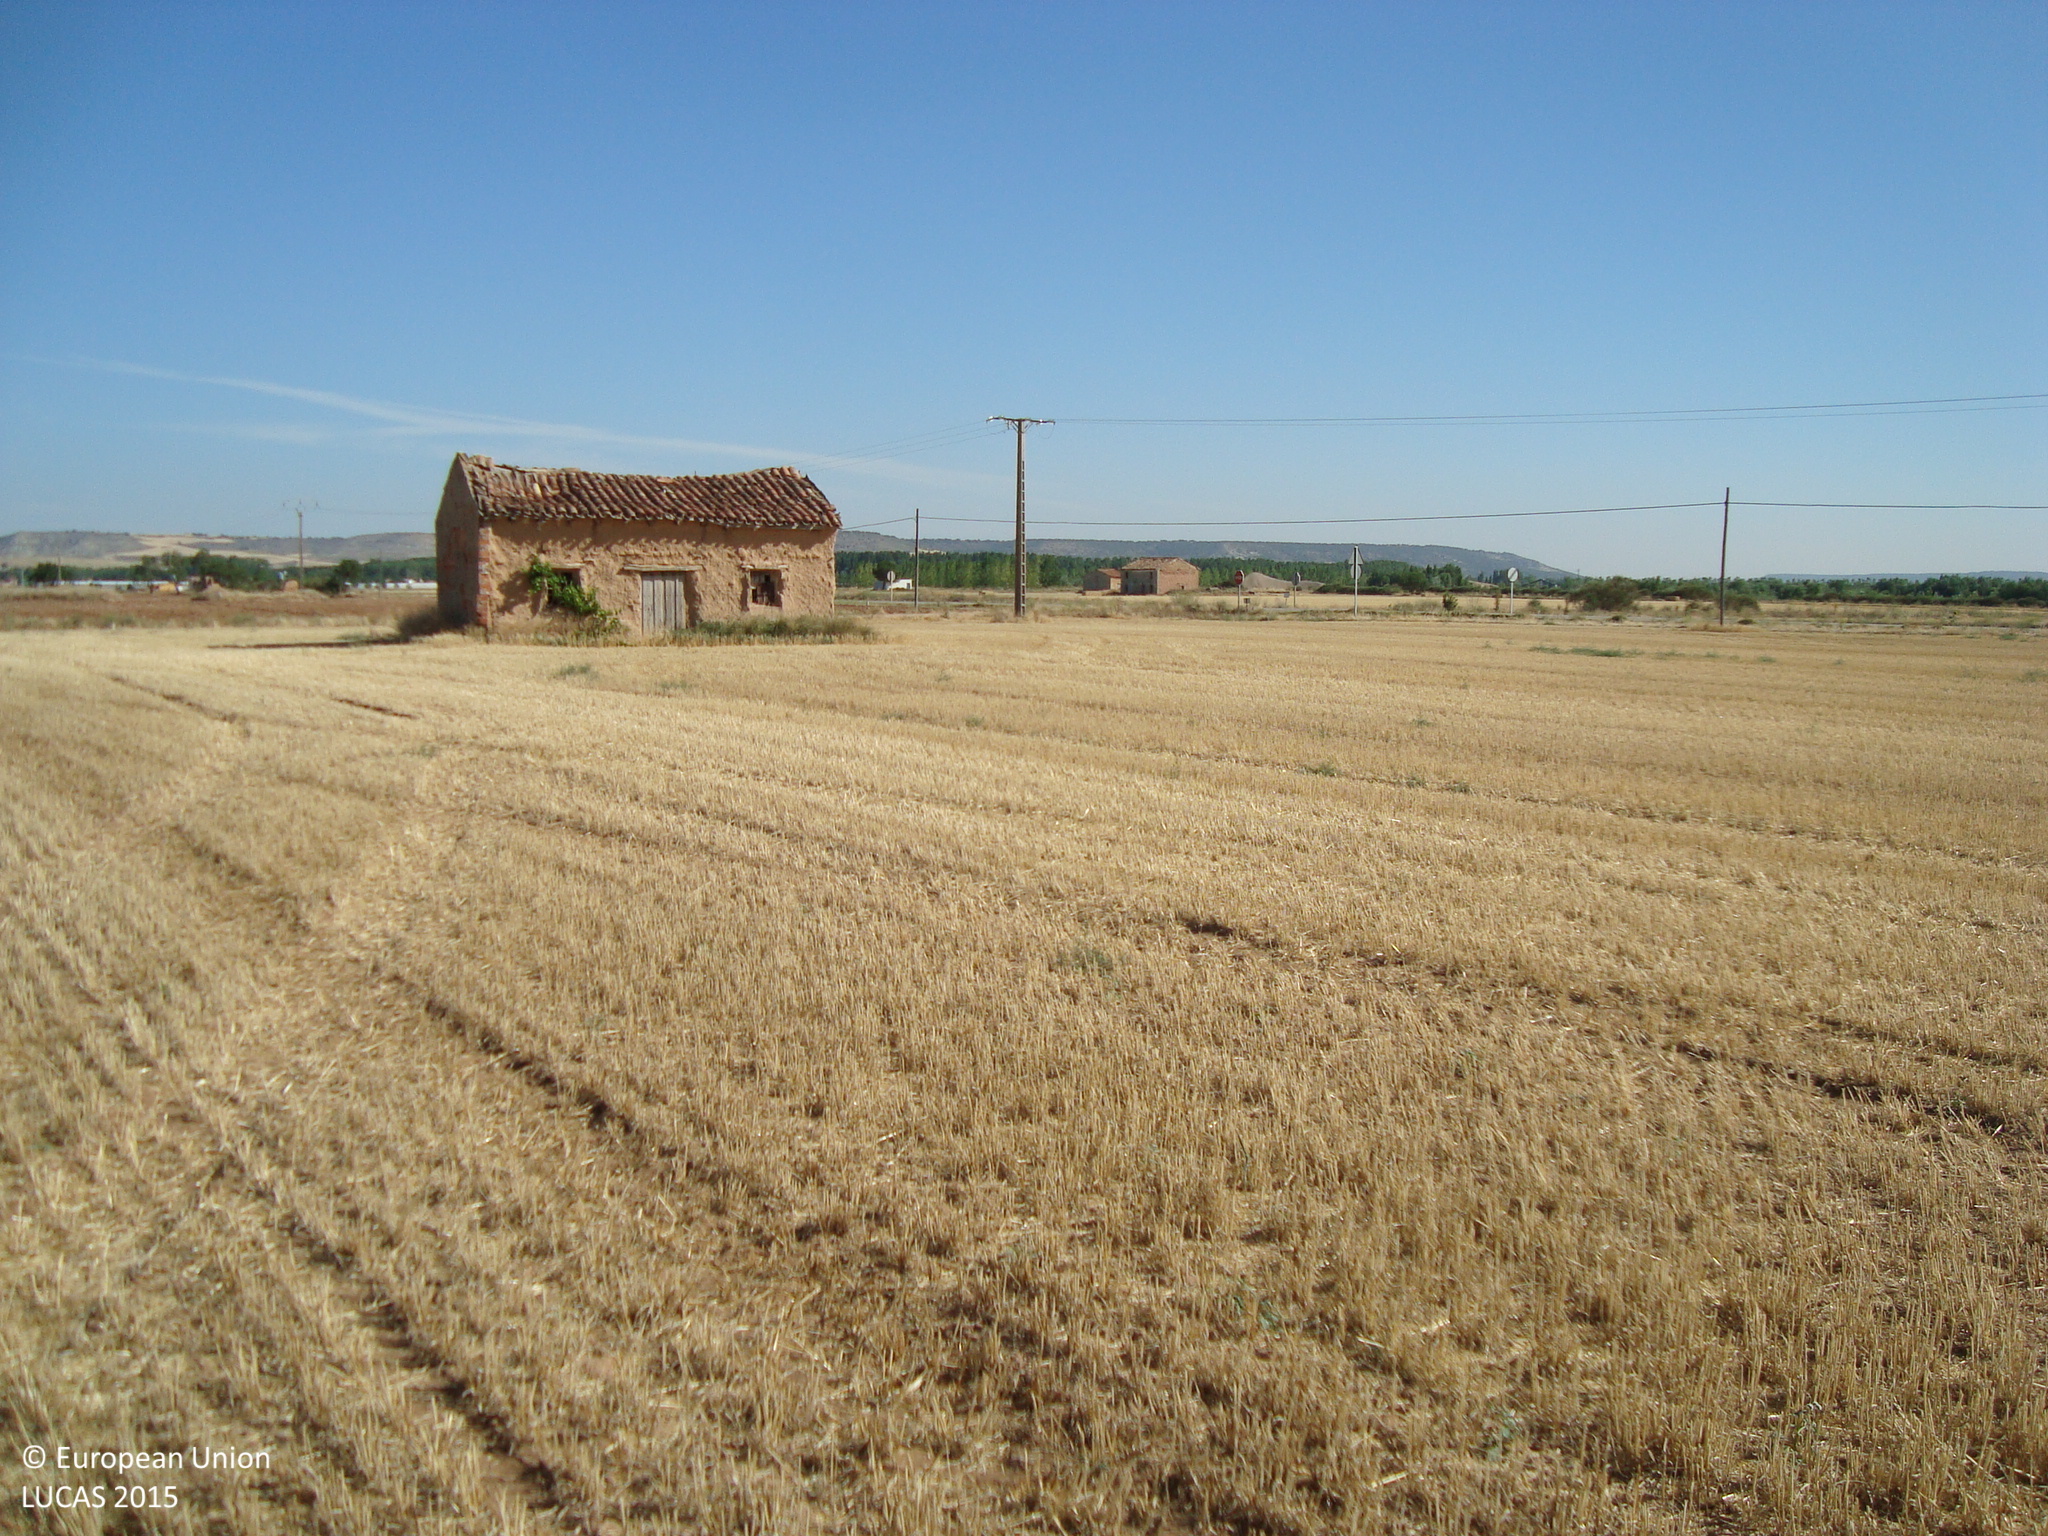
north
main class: Cropland
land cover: Barley
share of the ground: < 10 %
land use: Agriculture (excluding fallow land and kitchen gardens)
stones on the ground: < 10 %
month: July
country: ES
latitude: 42.0174
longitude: -4.3041
